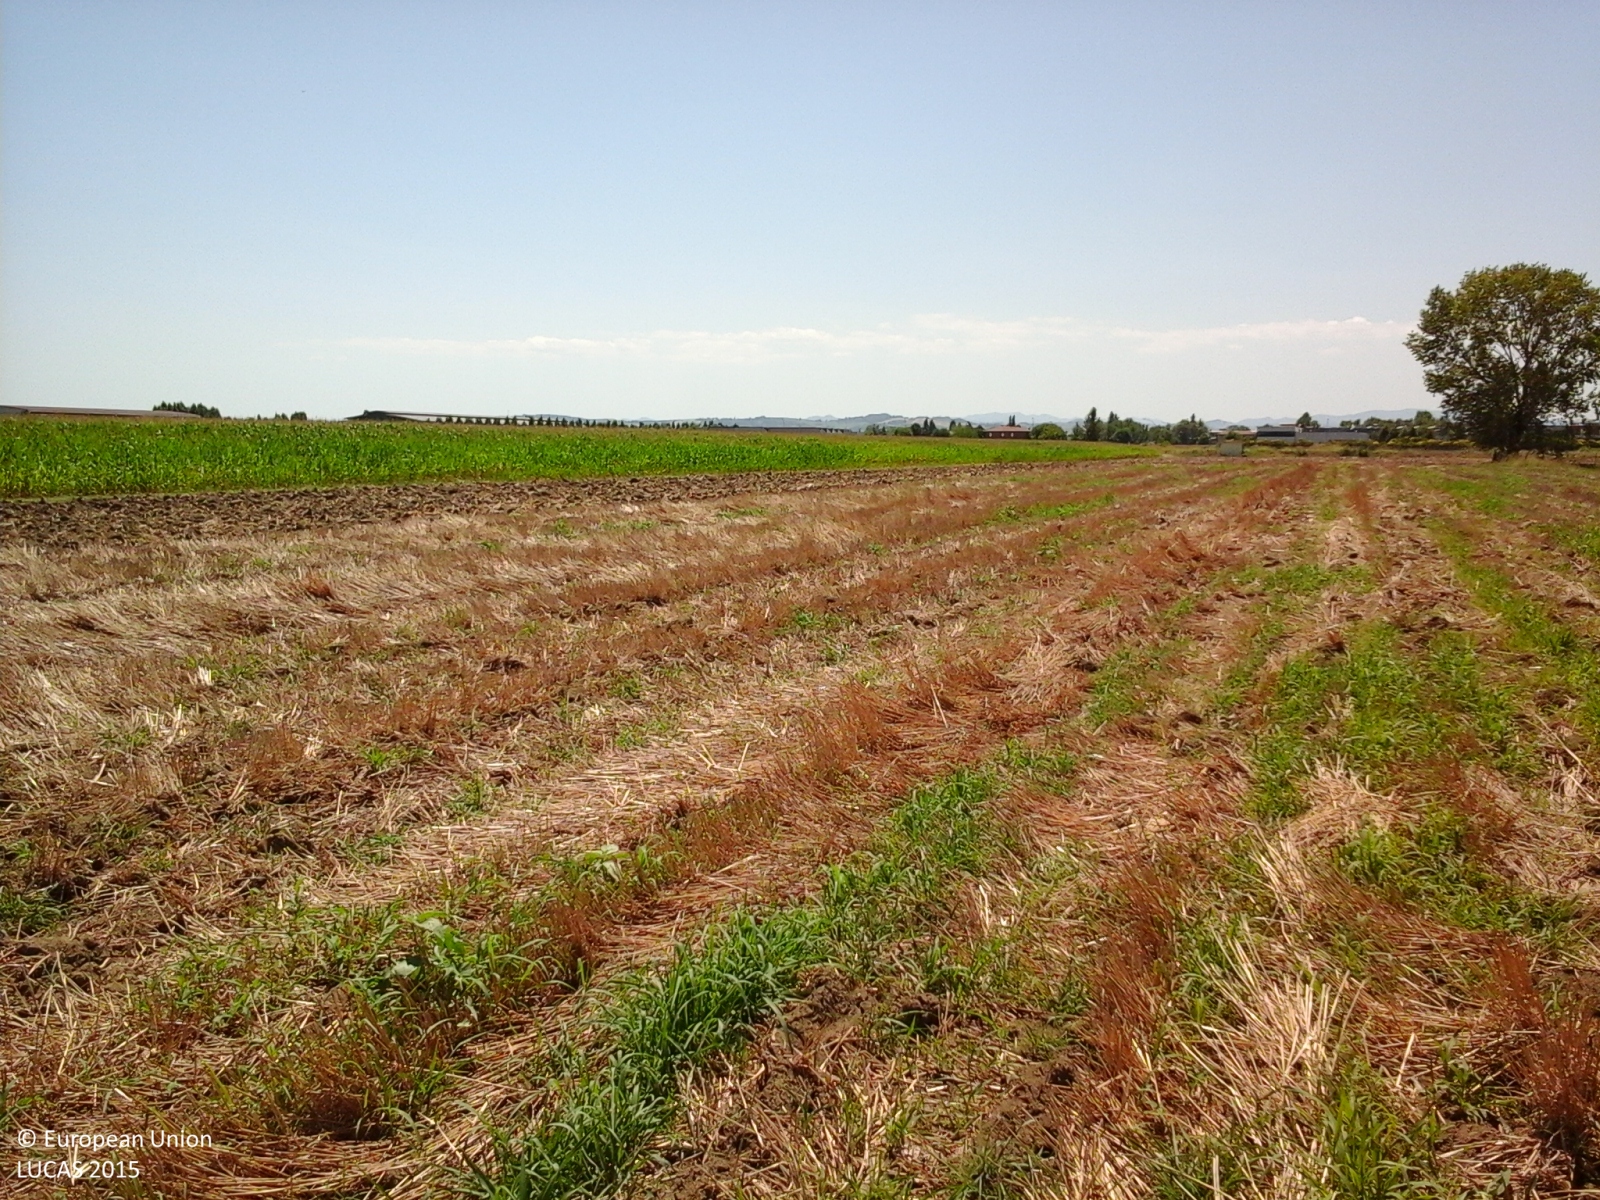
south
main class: Cropland
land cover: Common wheat
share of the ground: > 75 %
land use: Agriculture (excluding fallow land and kitchen gardens)
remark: Harvested field
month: July
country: IT
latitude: 44.4462
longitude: 11.6174
